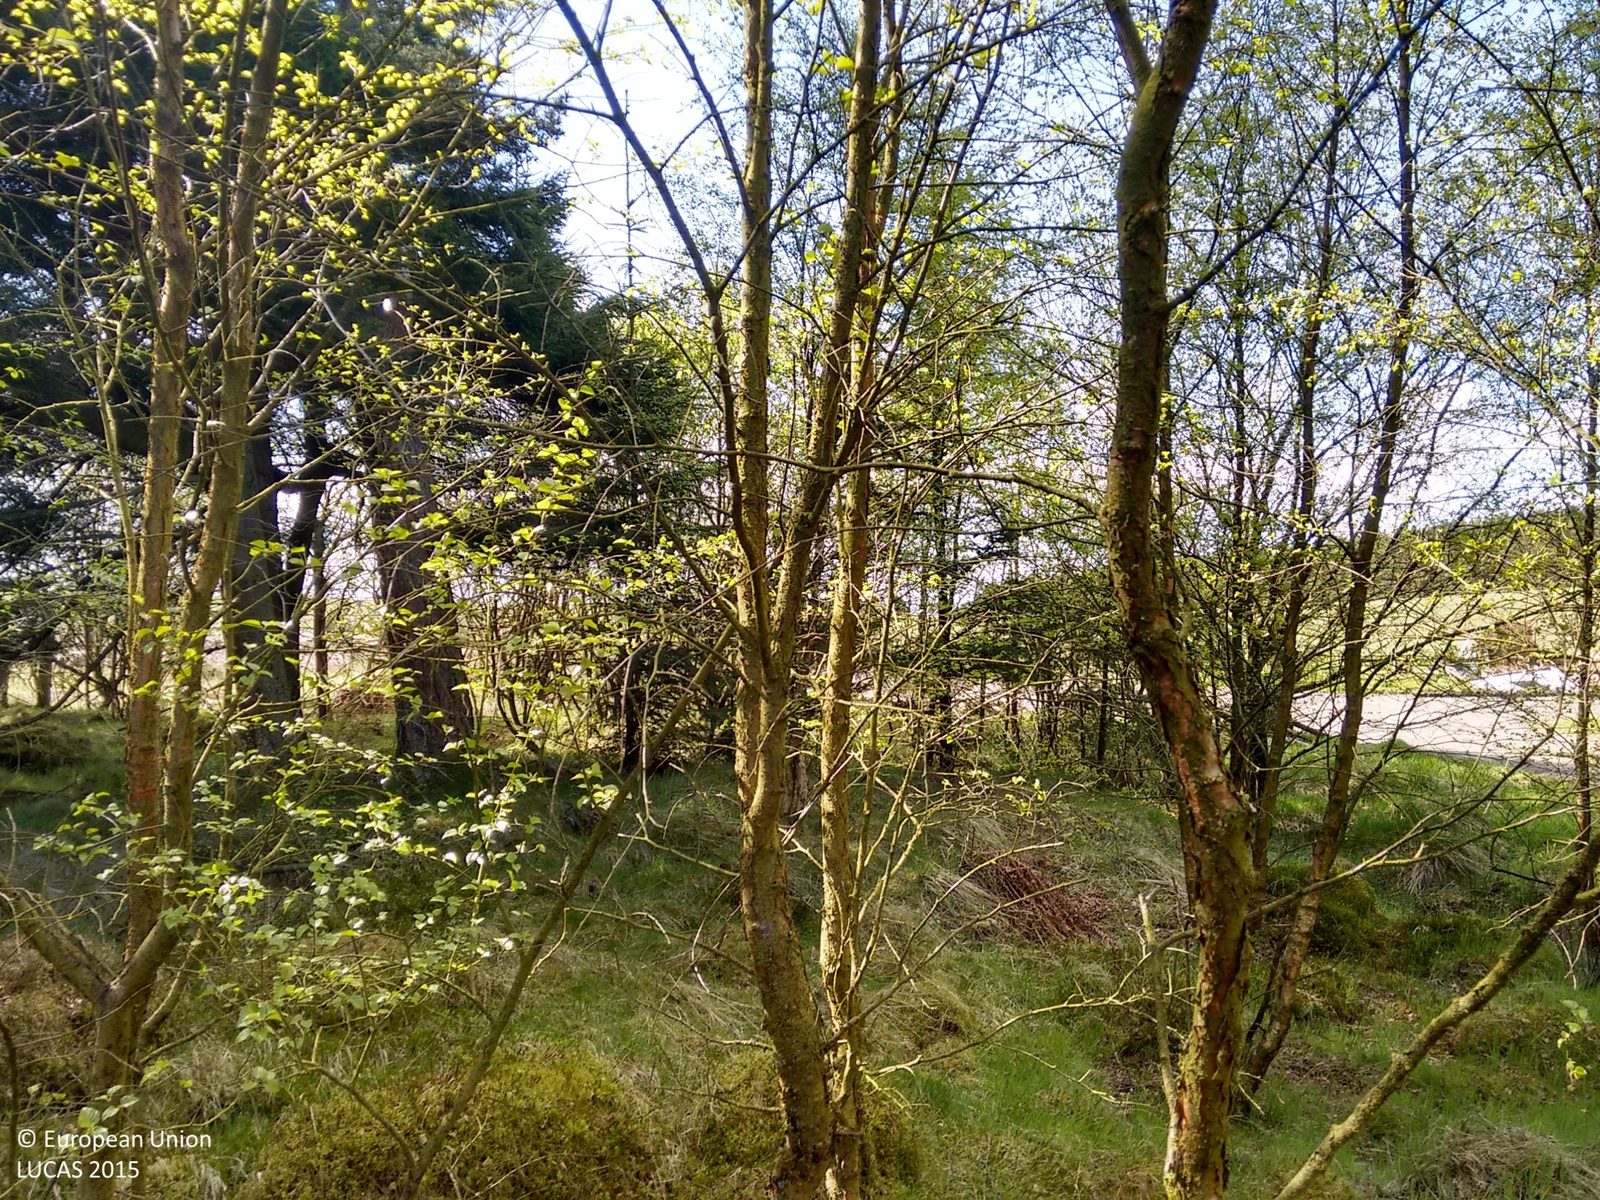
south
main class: Woodland
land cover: Broadleaved woodland
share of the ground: > 75 %
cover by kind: broadleaved forest trees 100 %
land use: Forestry
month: May
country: GB
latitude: 56.1908
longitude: -3.9272
